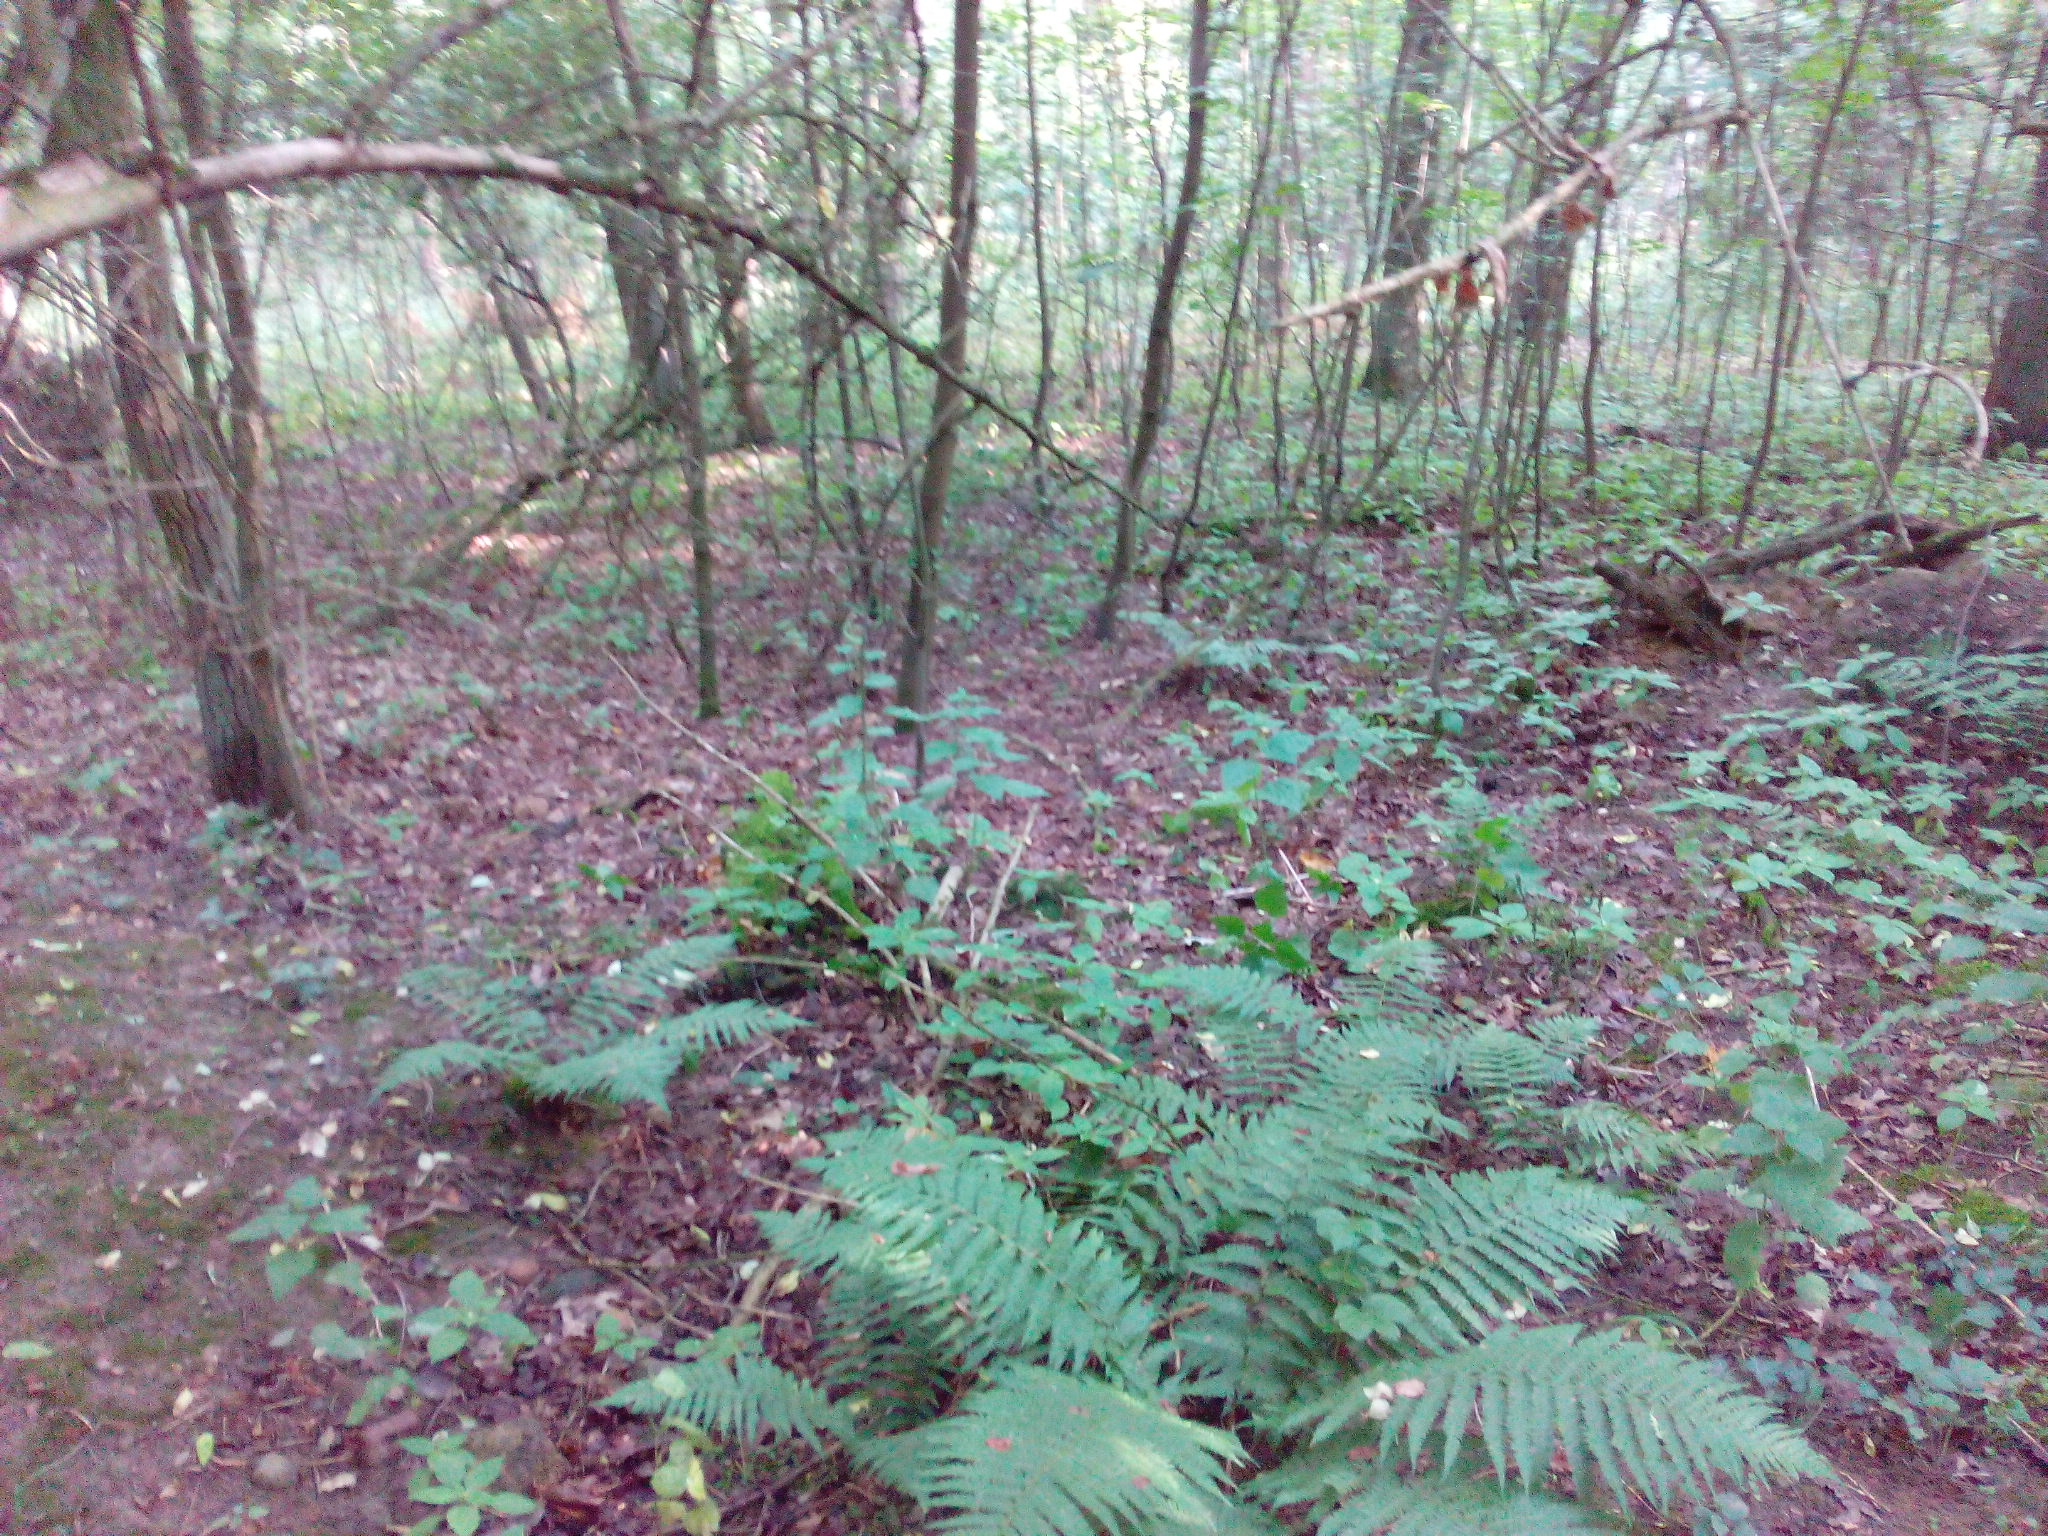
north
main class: Woodland
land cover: Other mixed woodland
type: hemiboreal forest and nemoral coniferous forest and mixed broadleaved-coniferous forest
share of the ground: > 75 %
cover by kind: broadleaved forest trees 50 %, coniferous forest trees 40 %, shrubs 5 %, herbaceous plants 5 %
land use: Forestry
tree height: > 5 m
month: July
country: DE
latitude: 53.1860
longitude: 14.1760
